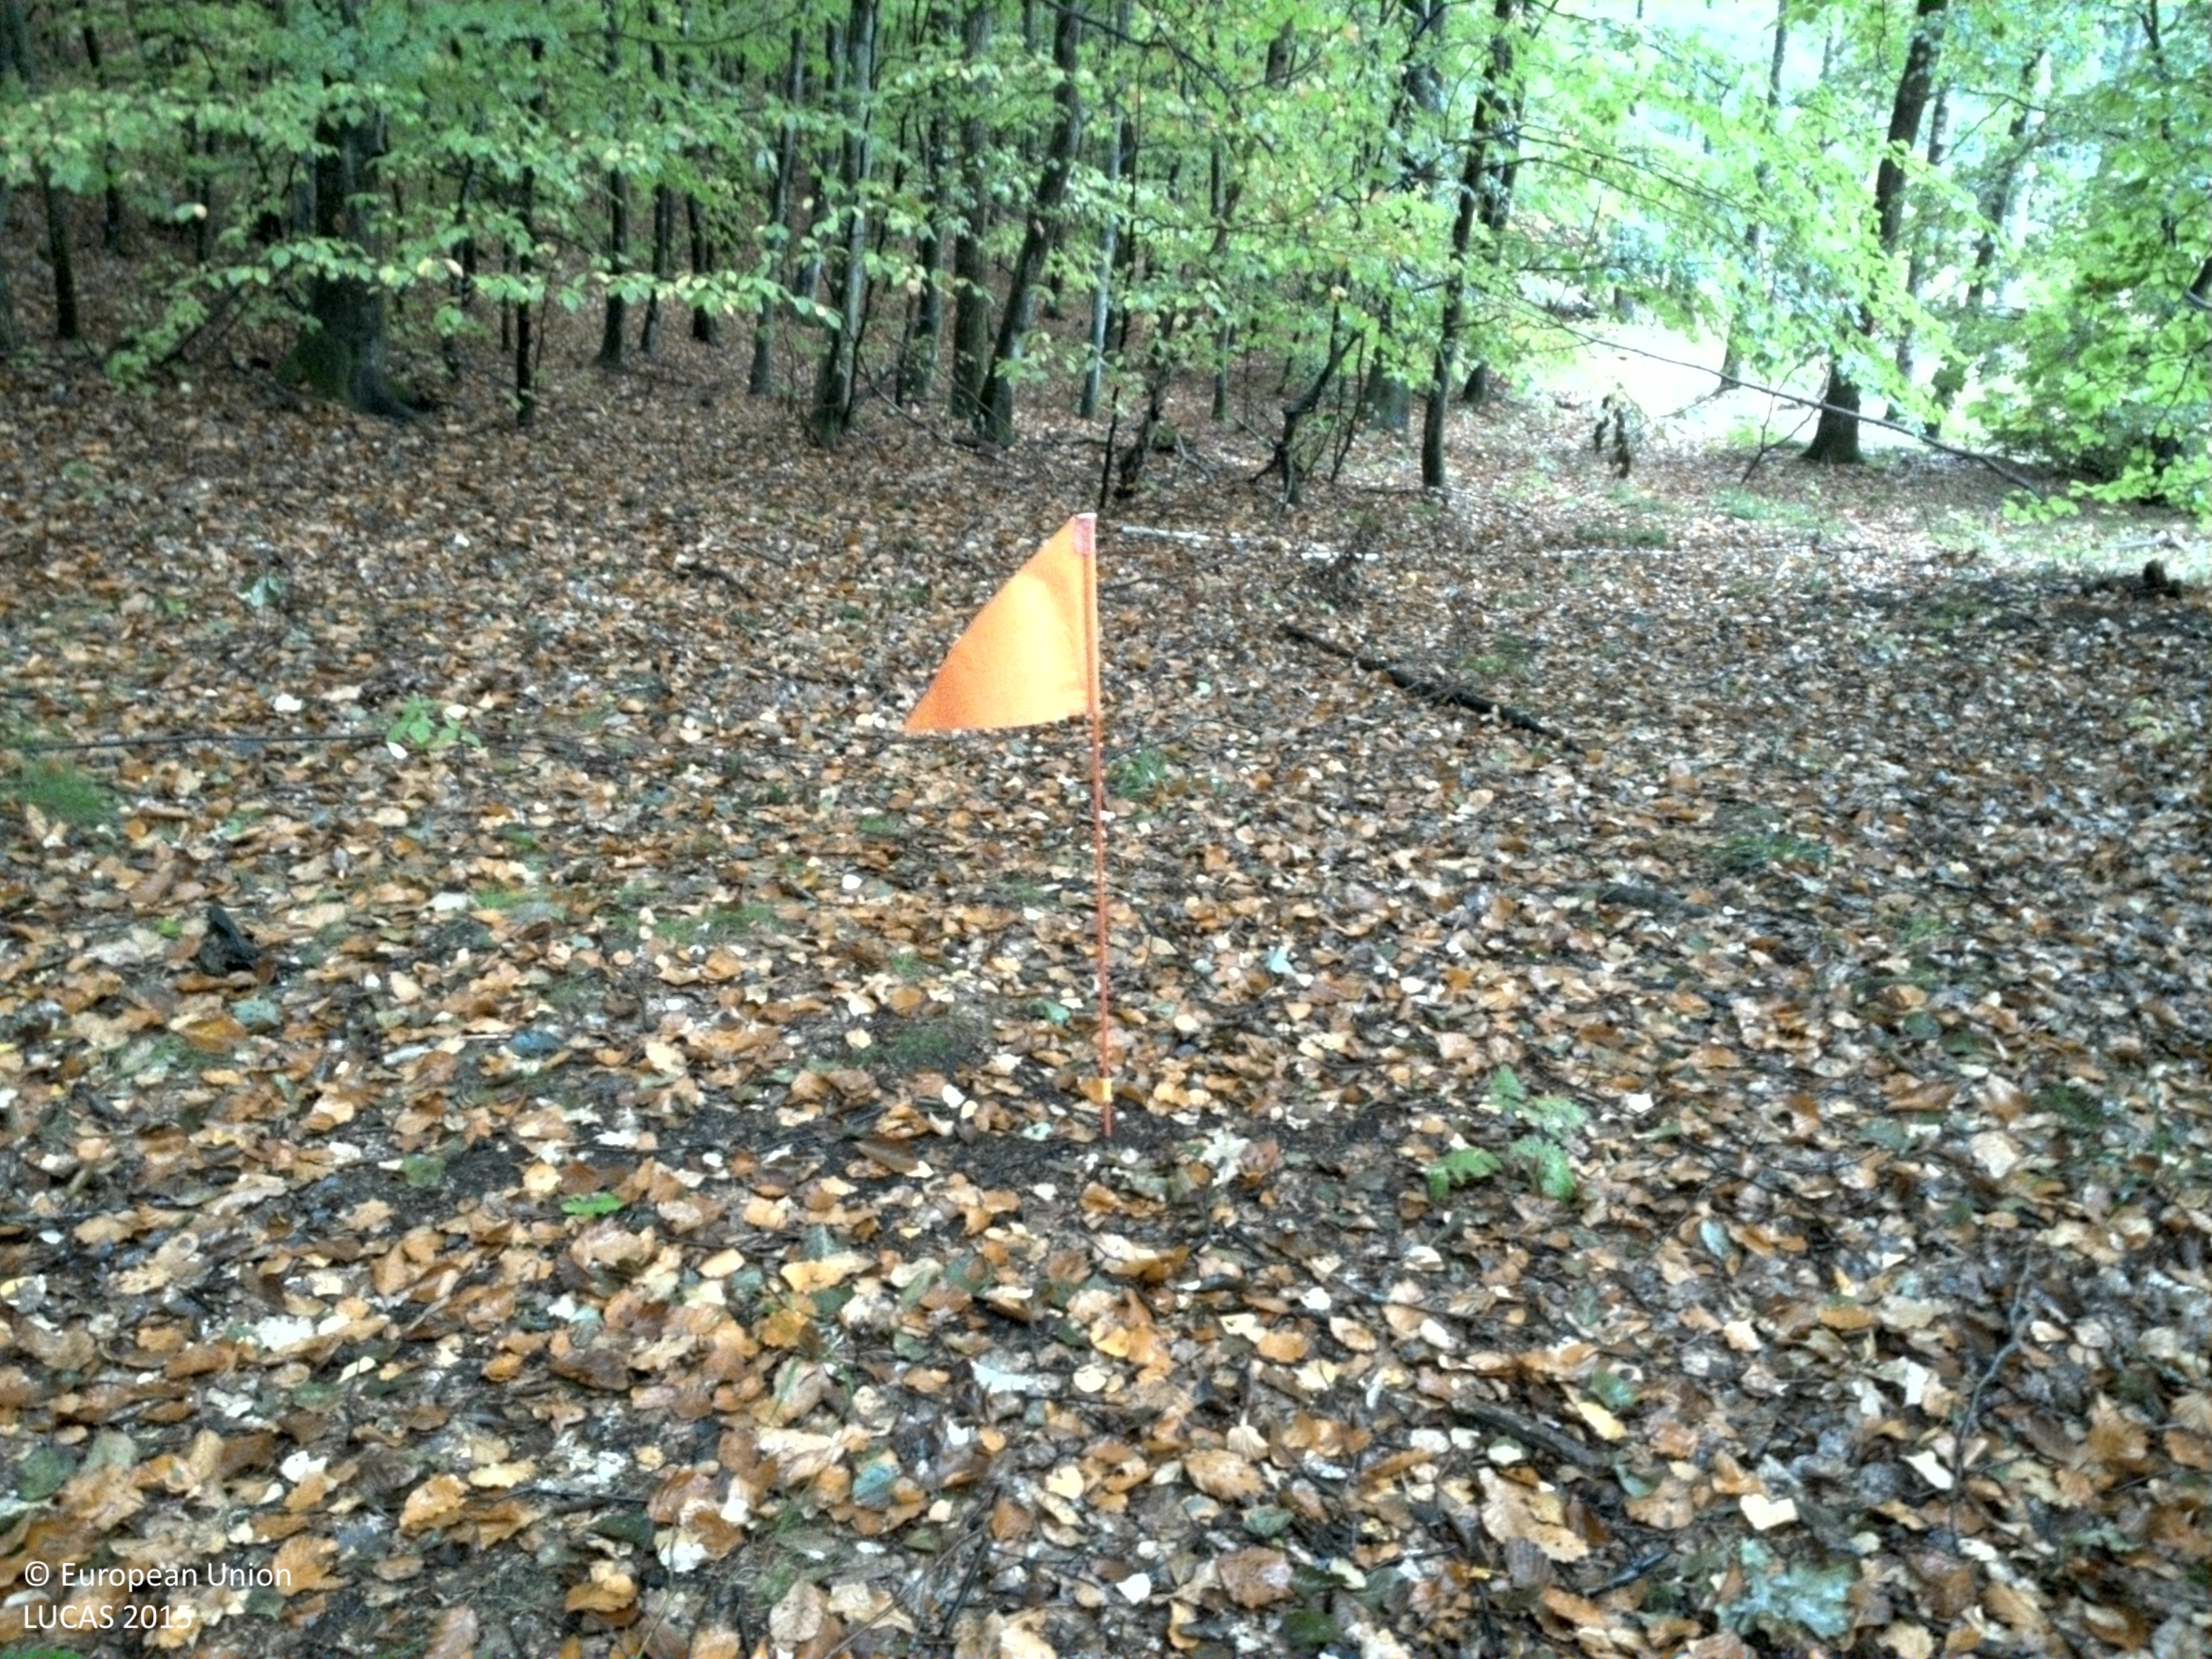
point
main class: Woodland
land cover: Broadleaved woodland
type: beech forest
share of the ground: > 75 %
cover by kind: broadleaved forest trees 80 %, unconsolidated bare surface 15 %, shrubs 5 %
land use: Forestry
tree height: > 5 m
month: October
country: SE
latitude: 55.7276
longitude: 14.0586
